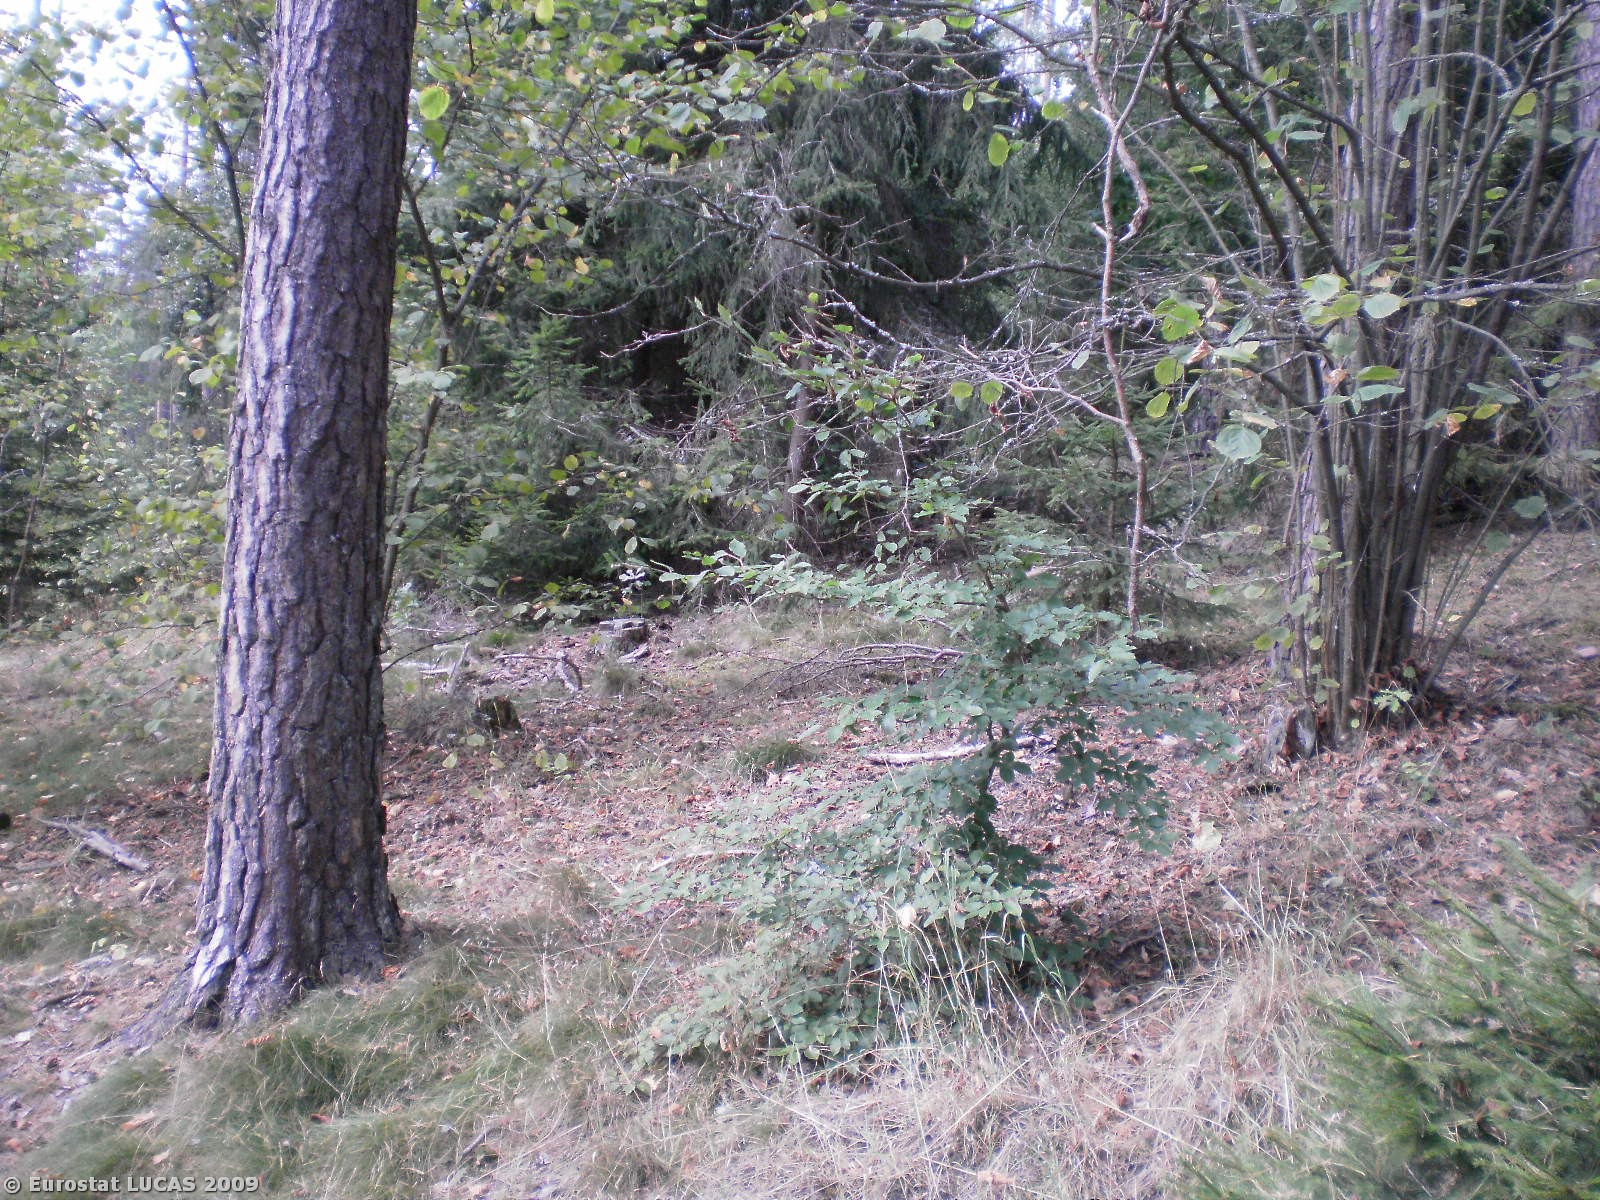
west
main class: Woodland
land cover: Coniferous woodland
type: hemiboreal forest and nemoral coniferous forest and mixed broadleaved-coniferous forest
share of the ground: 50 - 75 %
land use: Forestry
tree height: > 5 m
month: September
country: PL
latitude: 53.7156
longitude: 21.3976
